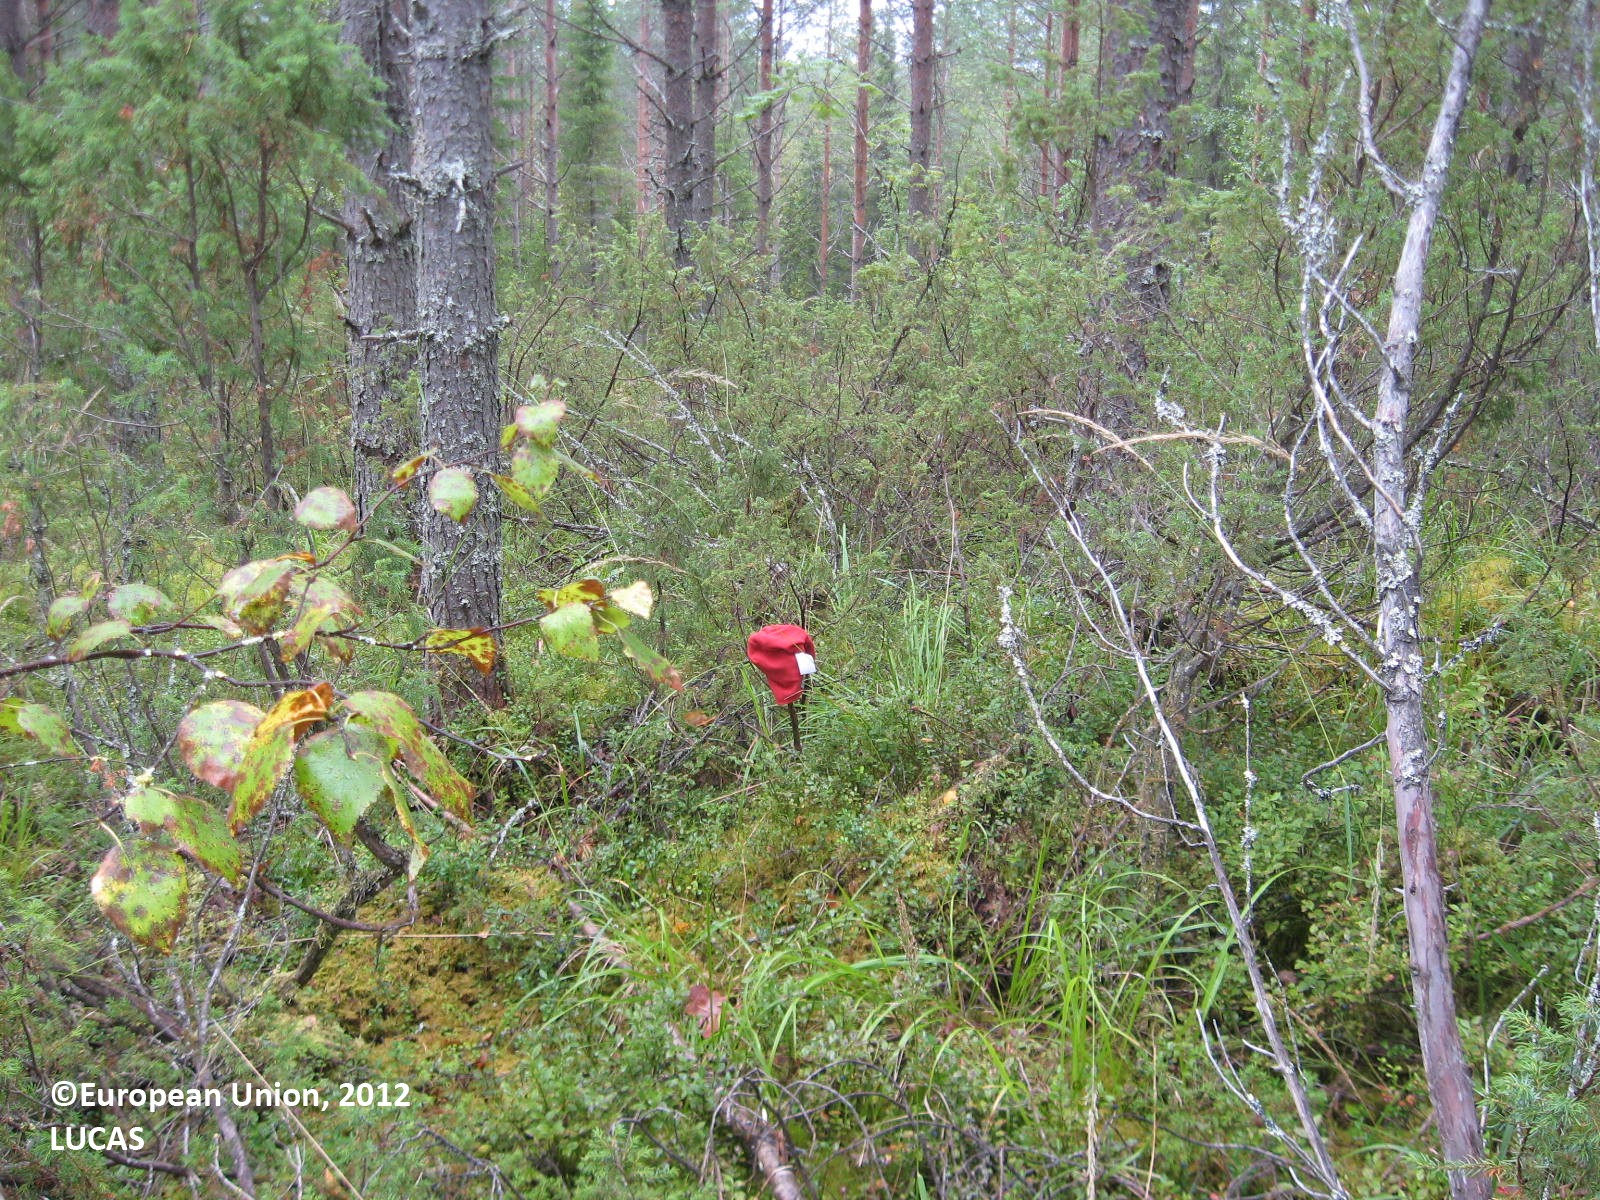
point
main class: Woodland
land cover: Pine dominated coniferous woodland
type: boreal forest
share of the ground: > 75 %
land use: Forestry
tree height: > 5 m
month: August
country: FI
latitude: 63.4999
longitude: 29.8261
